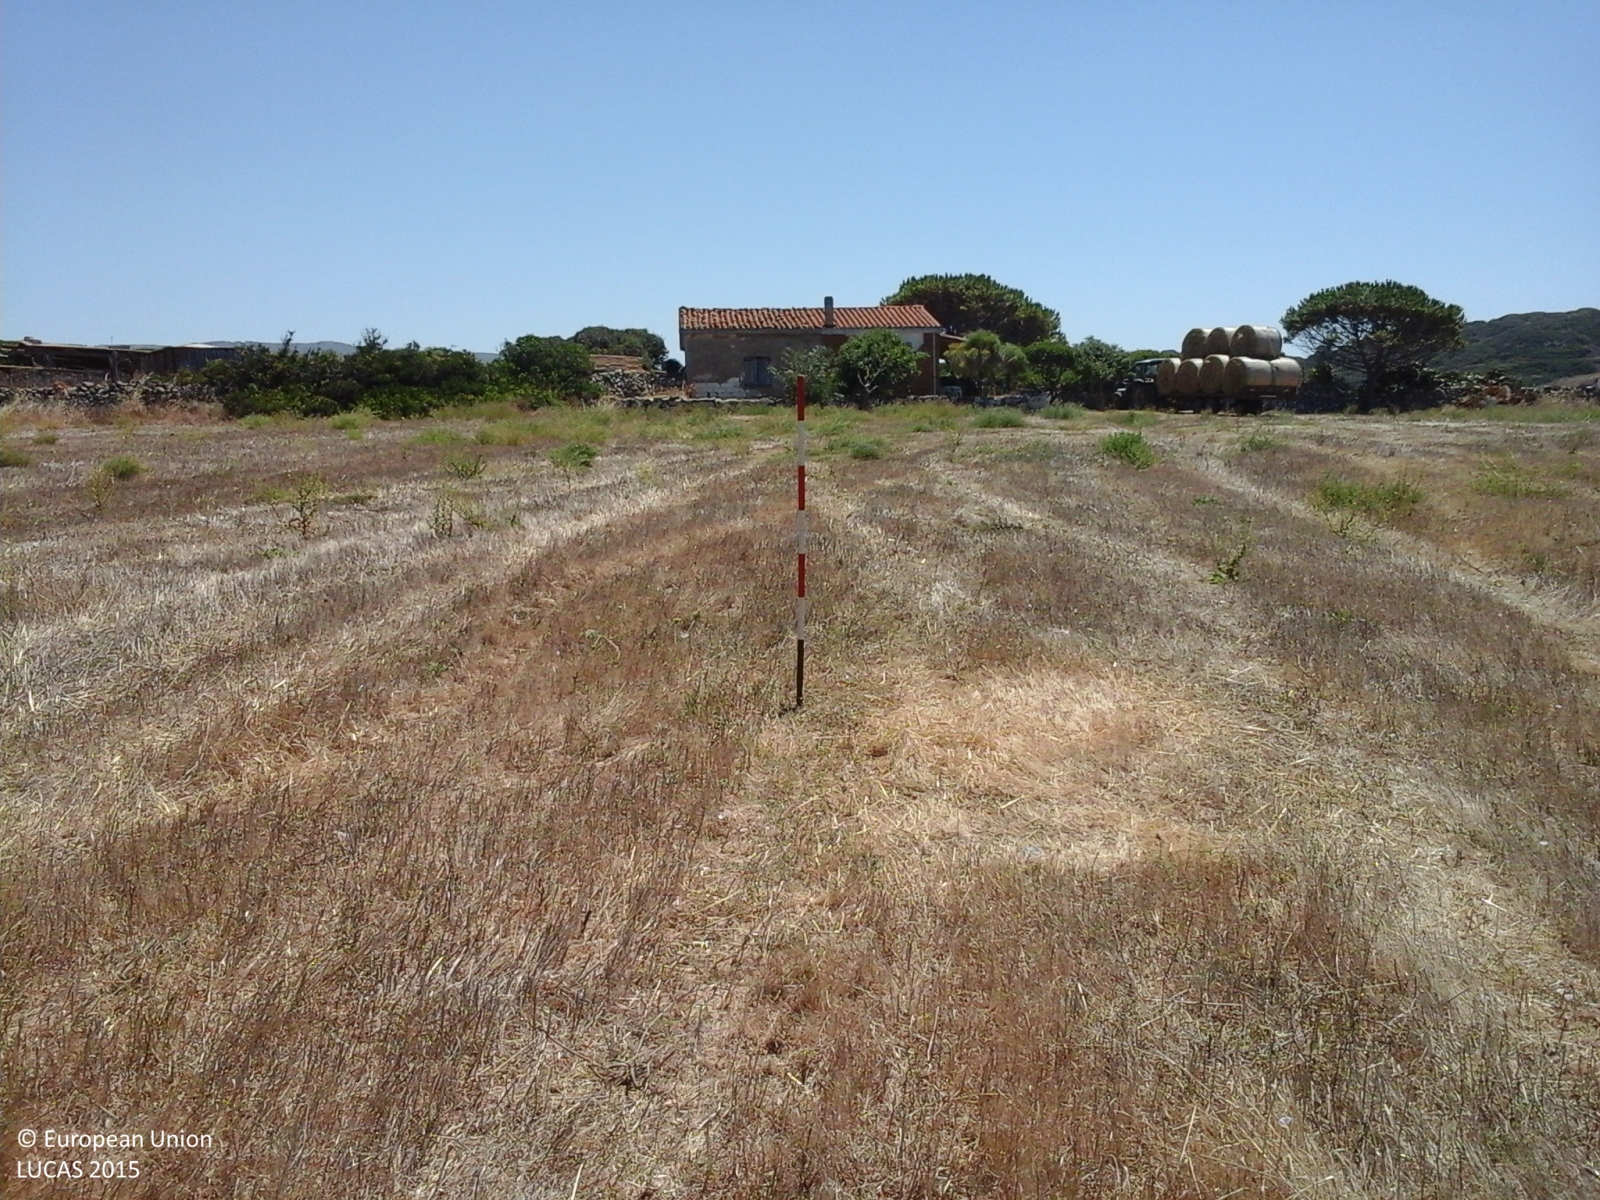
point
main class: Grassland
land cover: Grassland without tree/shrub cover
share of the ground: > 75 %
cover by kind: herbaceous plants 100 %
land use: Agriculture (excluding fallow land and kitchen gardens)
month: August
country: IT
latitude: 40.0928
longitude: 8.4950
